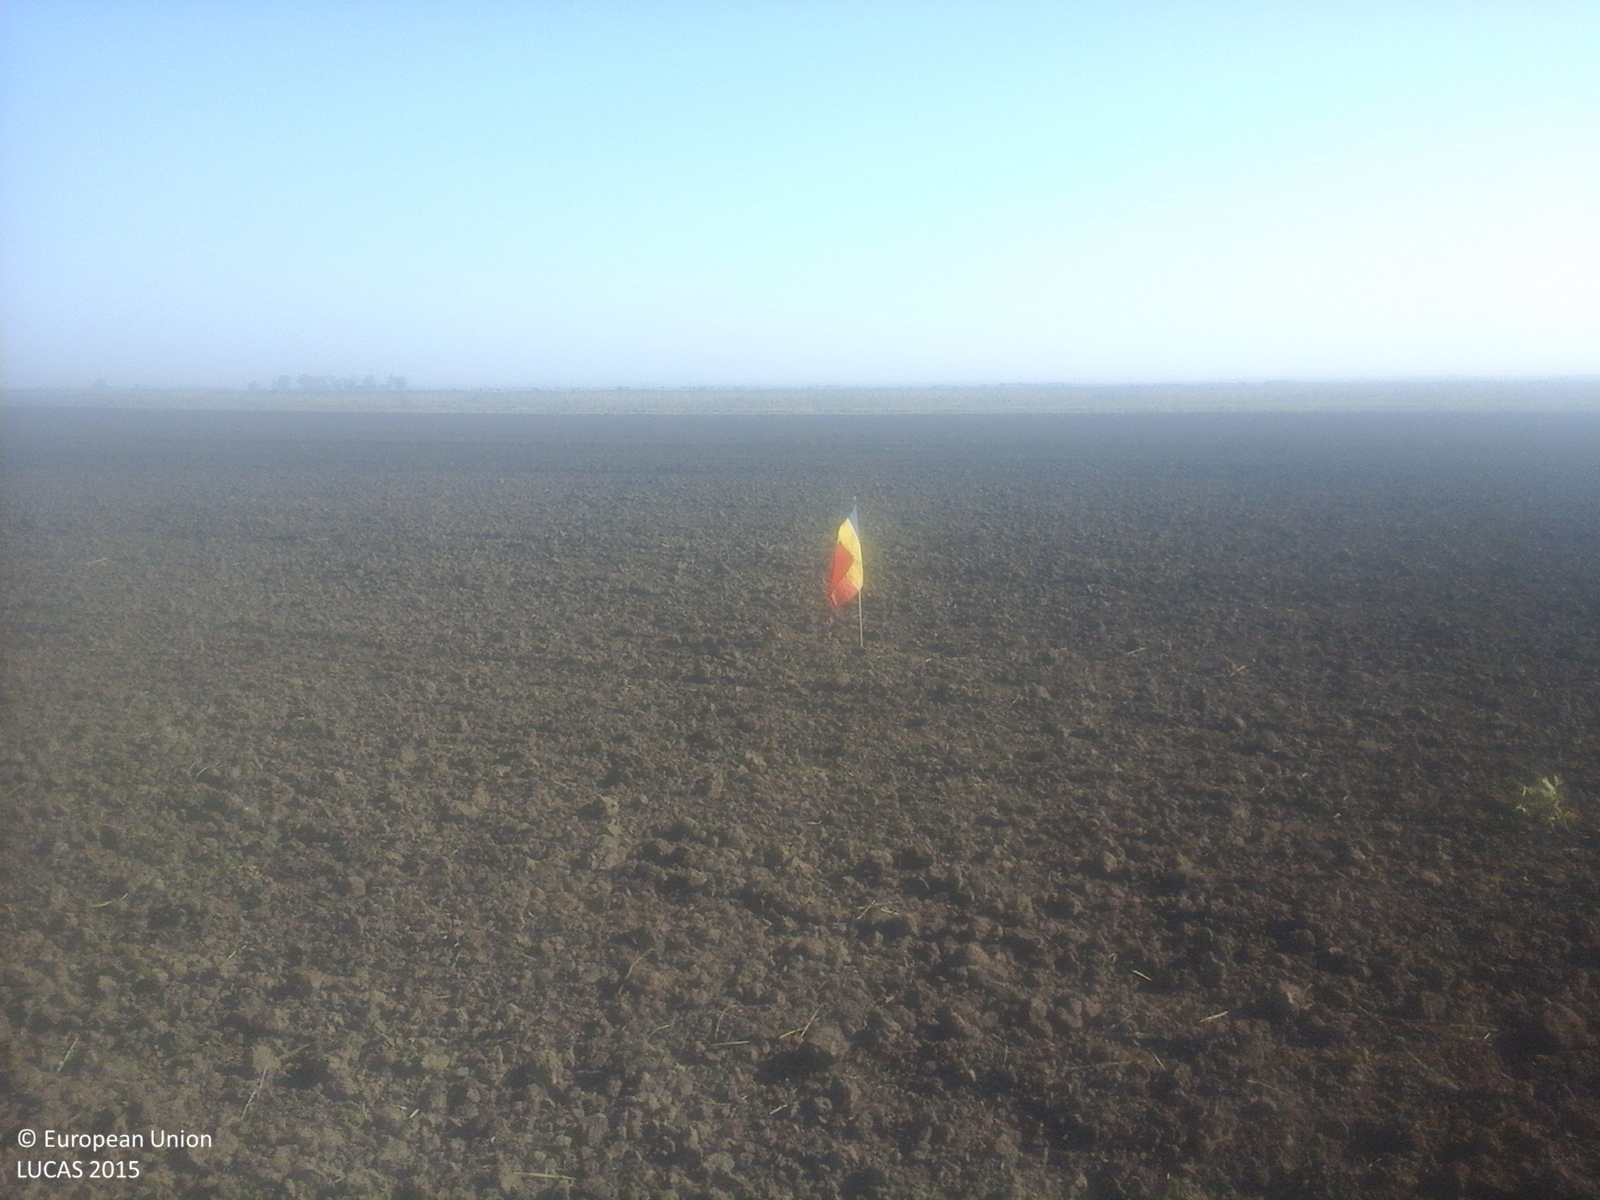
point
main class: Cropland
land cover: Common wheat
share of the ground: < 10 %
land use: Agriculture (excluding fallow land and kitchen gardens)
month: October
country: RO
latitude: 45.8568
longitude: 27.1340
